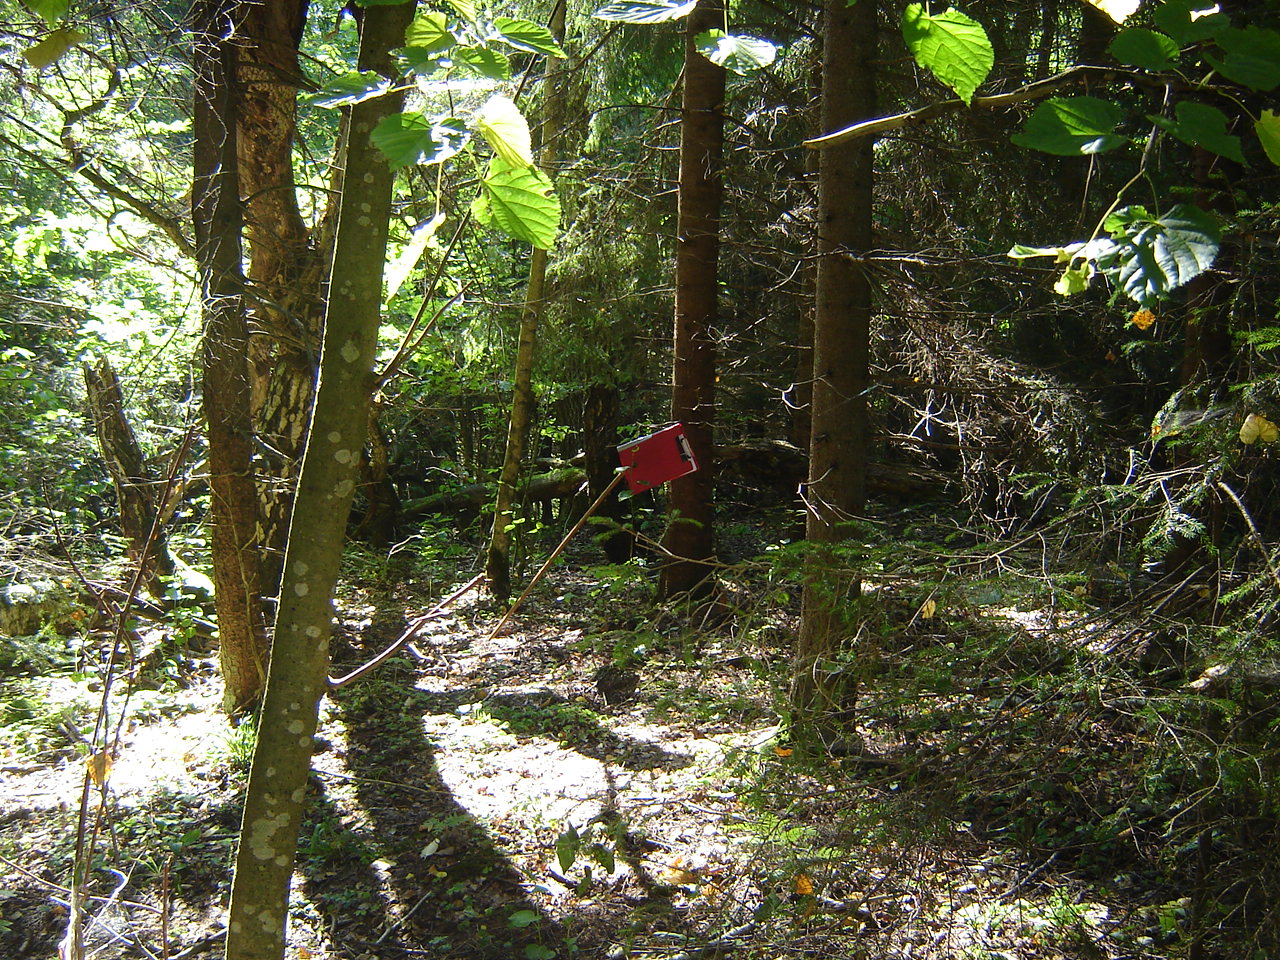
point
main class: Woodland
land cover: Other mixed woodland
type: hemiboreal forest and nemoral coniferous forest and mixed broadleaved-coniferous forest
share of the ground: > 75 %
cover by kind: coniferous forest trees 50 %, broadleaved forest trees 40 %, herbaceous plants 5 %, unconsolidated bare surface 5 %
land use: Forestry
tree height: > 5 m
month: August
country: LT
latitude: 55.0840
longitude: 25.1080
